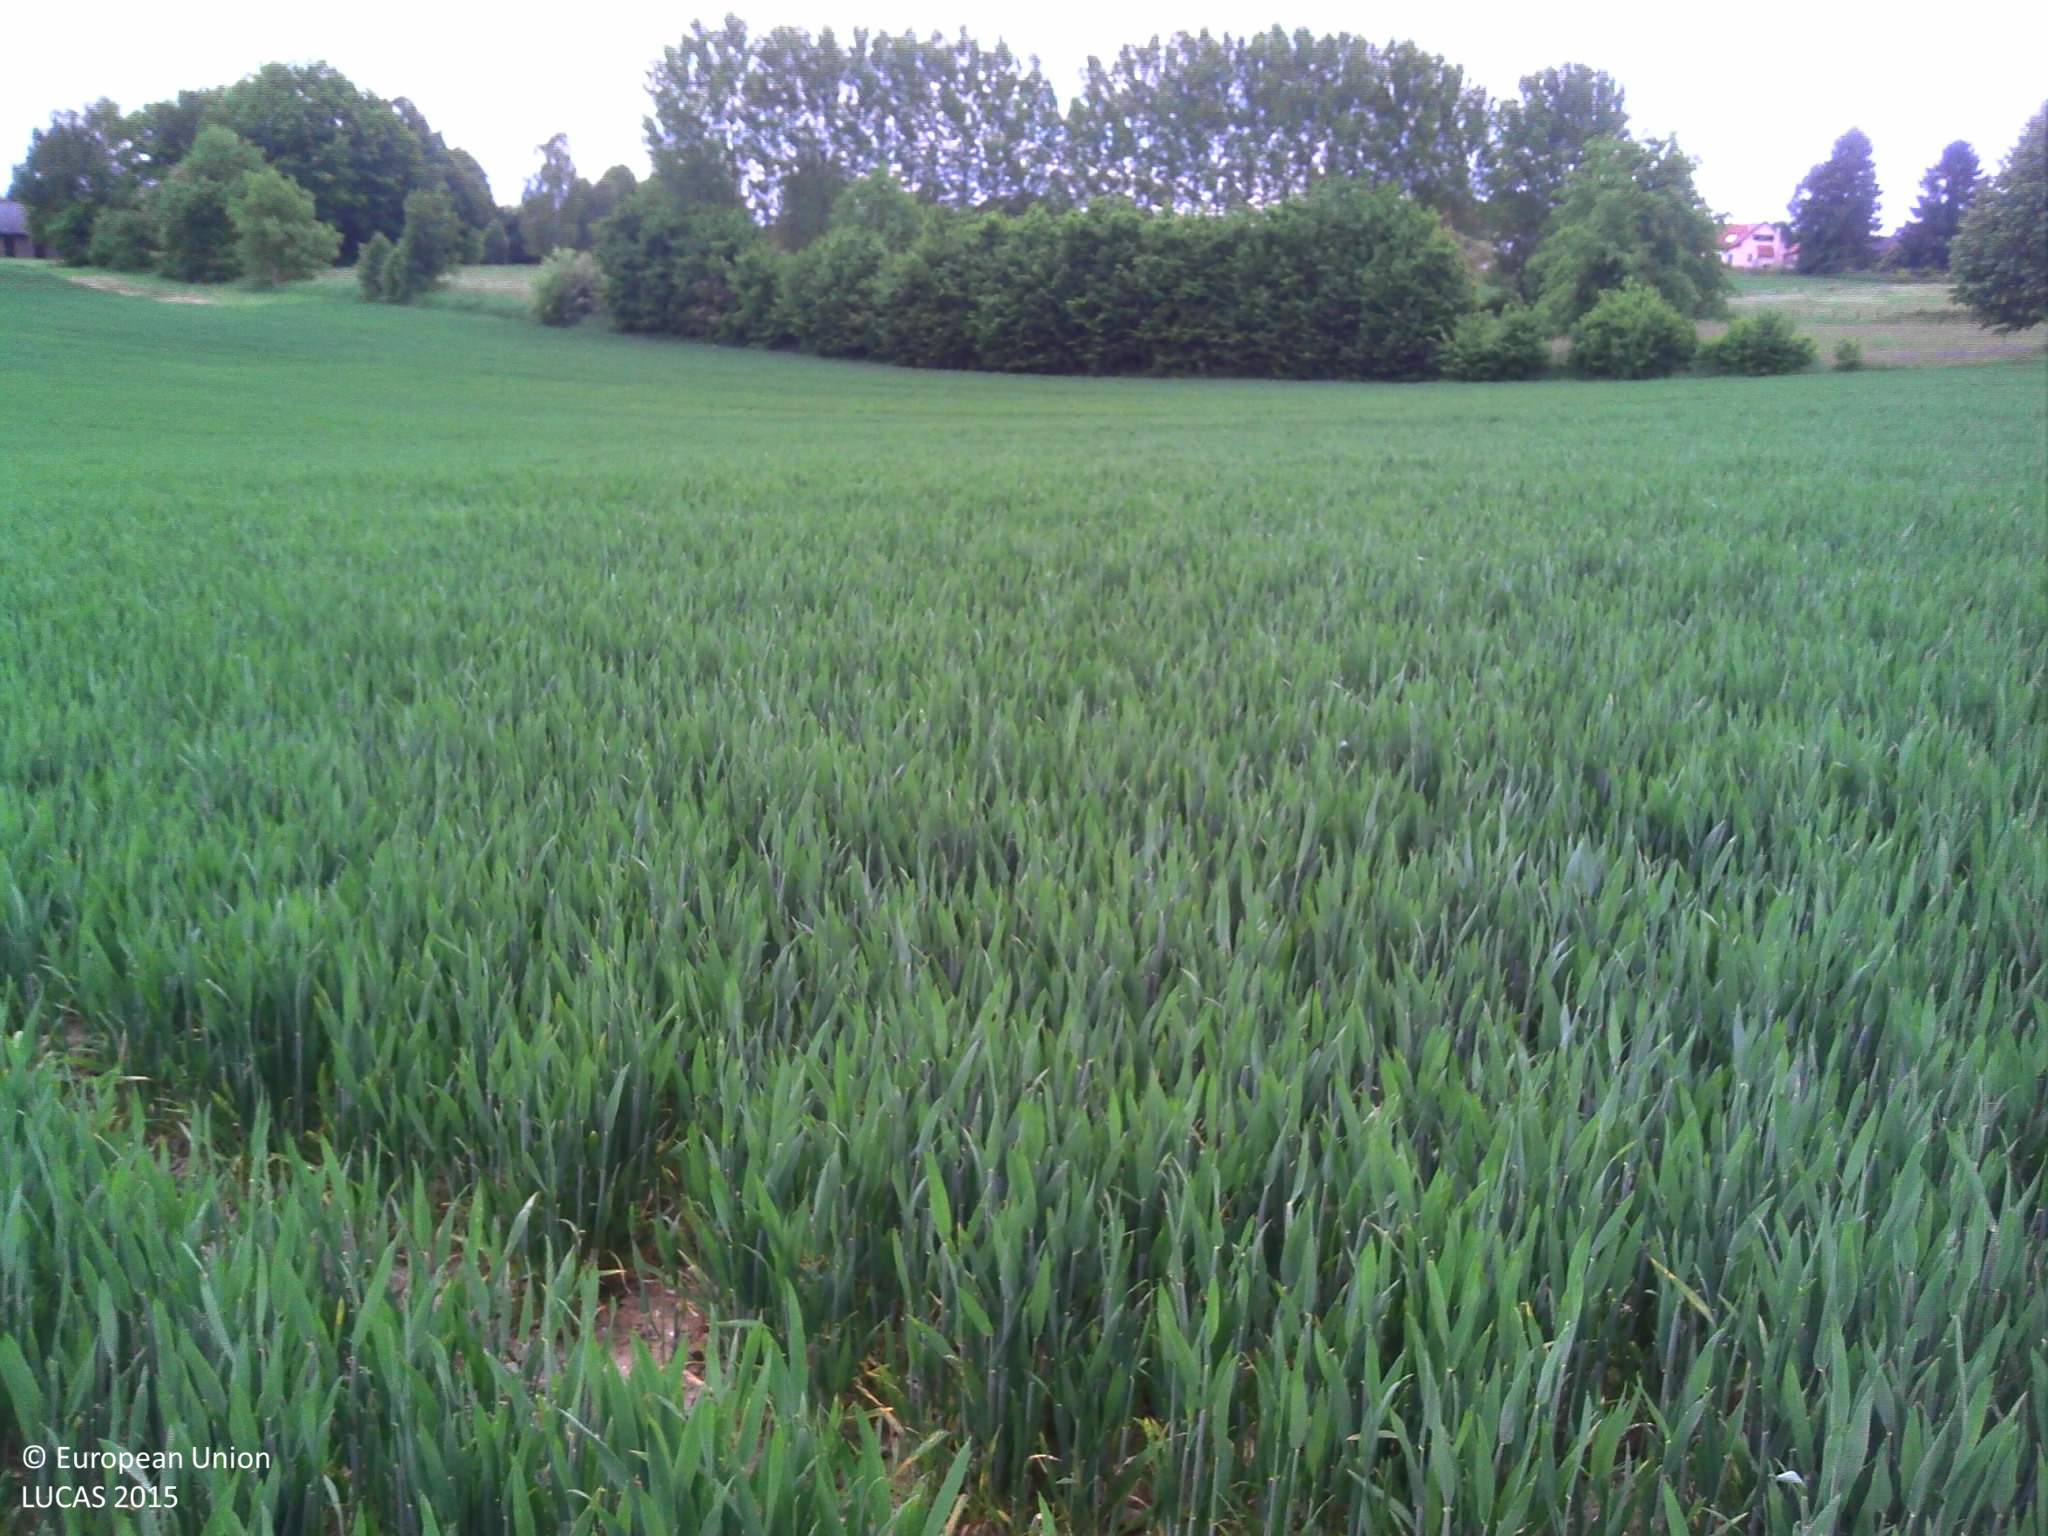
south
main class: Cropland
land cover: Common wheat
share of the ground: > 75 %
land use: Agriculture (excluding fallow land and kitchen gardens)
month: May
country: BE
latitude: 50.6626
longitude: 4.4642
